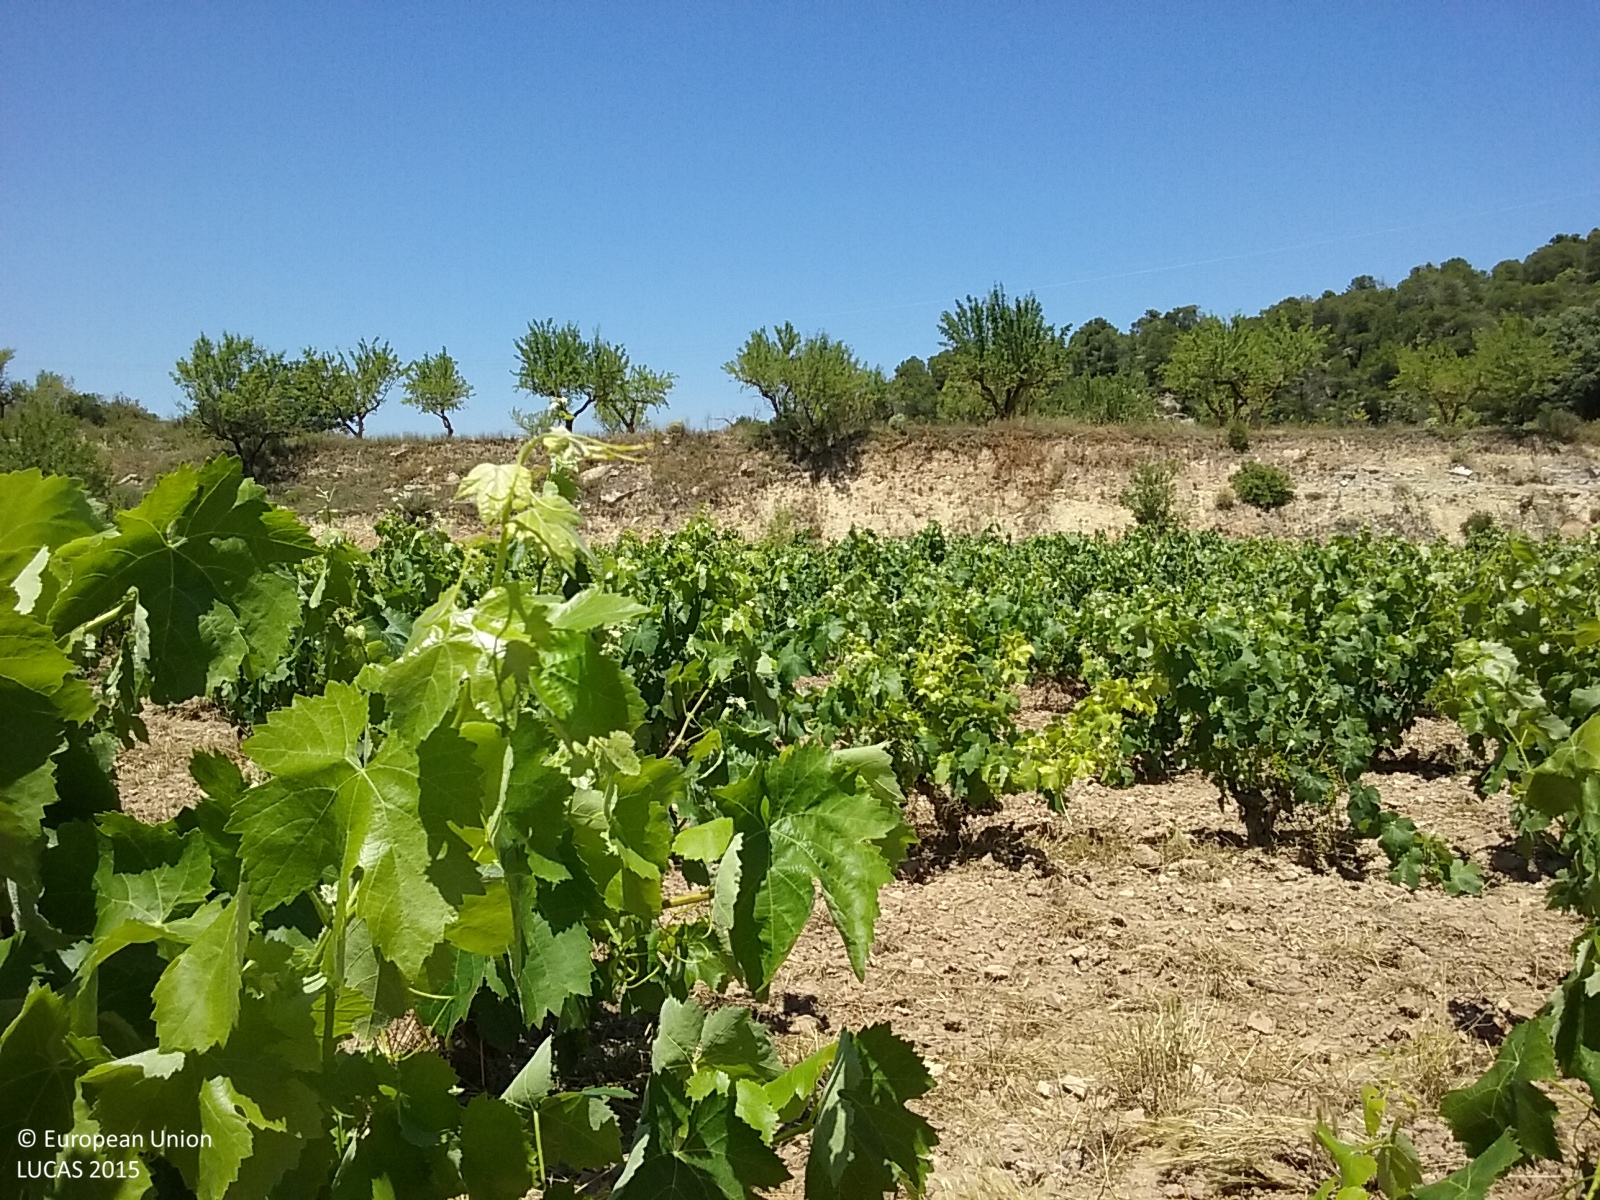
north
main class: Cropland
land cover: Vineyards
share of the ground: < 10 %
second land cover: Other bare soil
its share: > 75 %
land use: Agriculture (excluding fallow land and kitchen gardens)
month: June
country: ES
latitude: 41.1043
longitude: 0.3816
